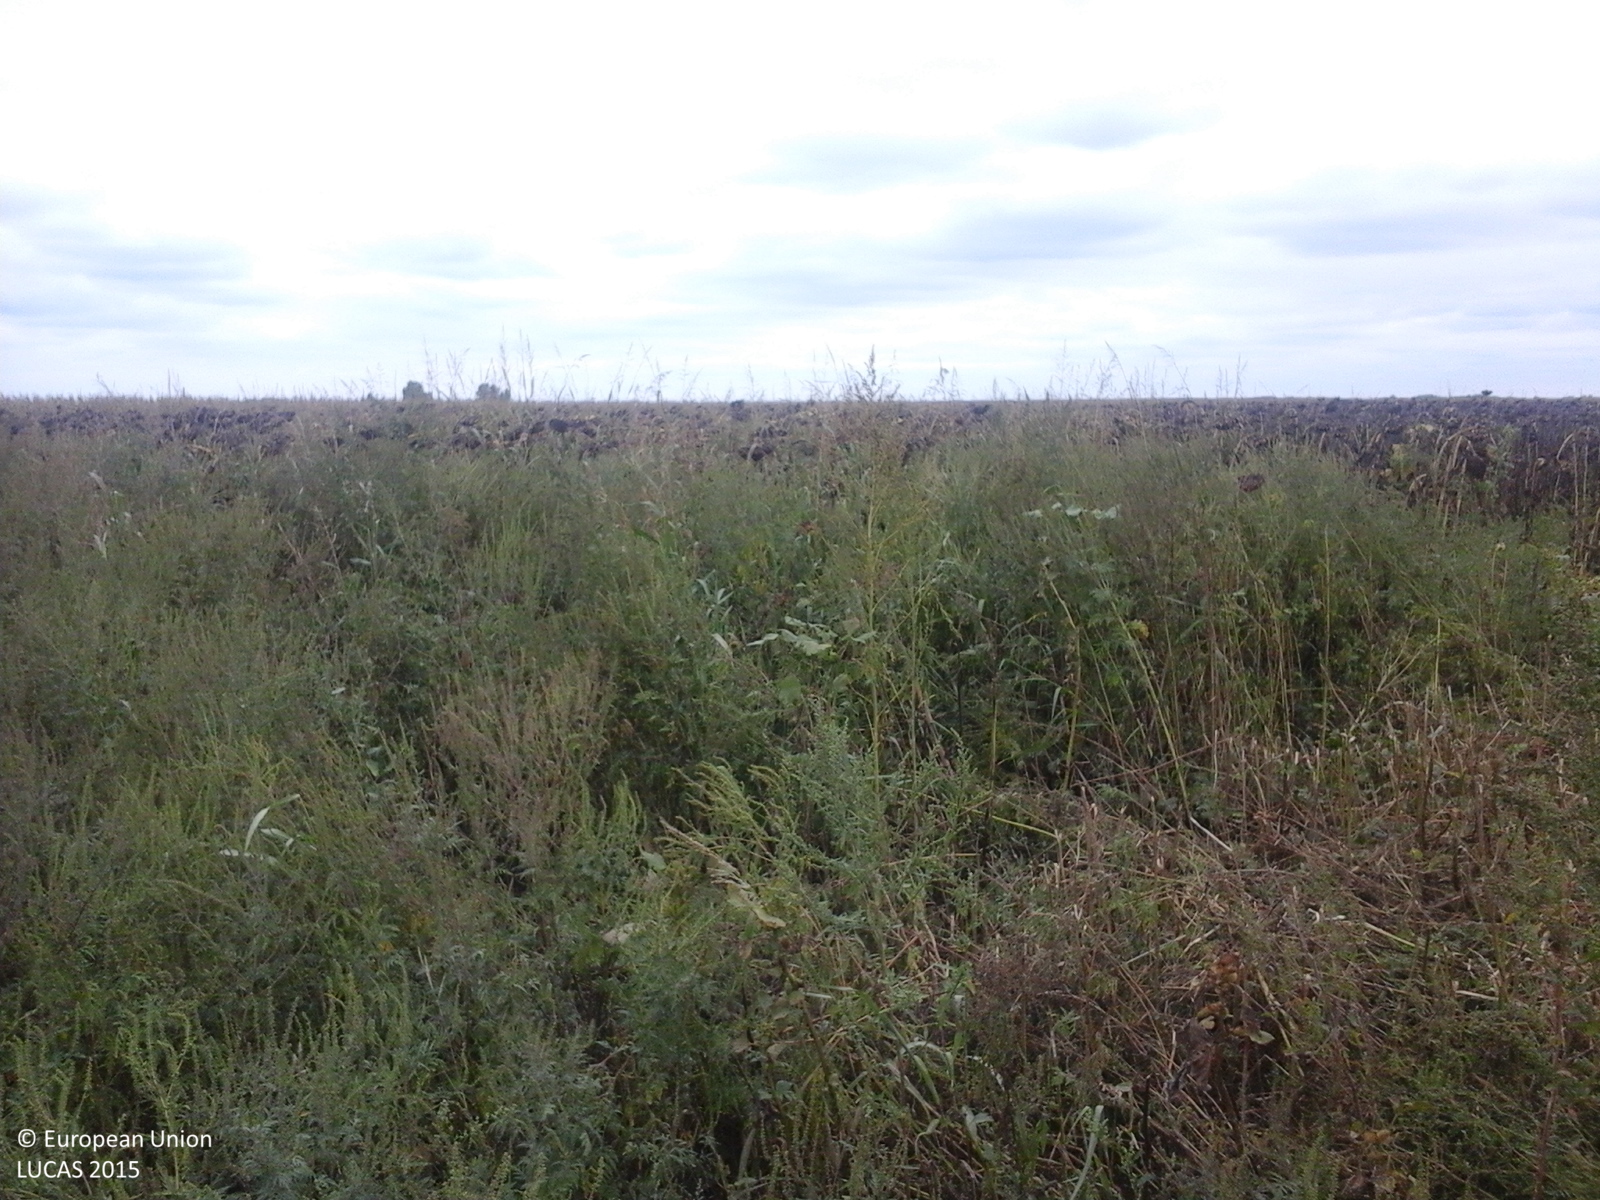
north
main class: Cropland
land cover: Soya
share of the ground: > 75 %
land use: Agriculture (excluding fallow land and kitchen gardens)
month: September
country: RO
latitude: 47.3704
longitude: 21.9535
